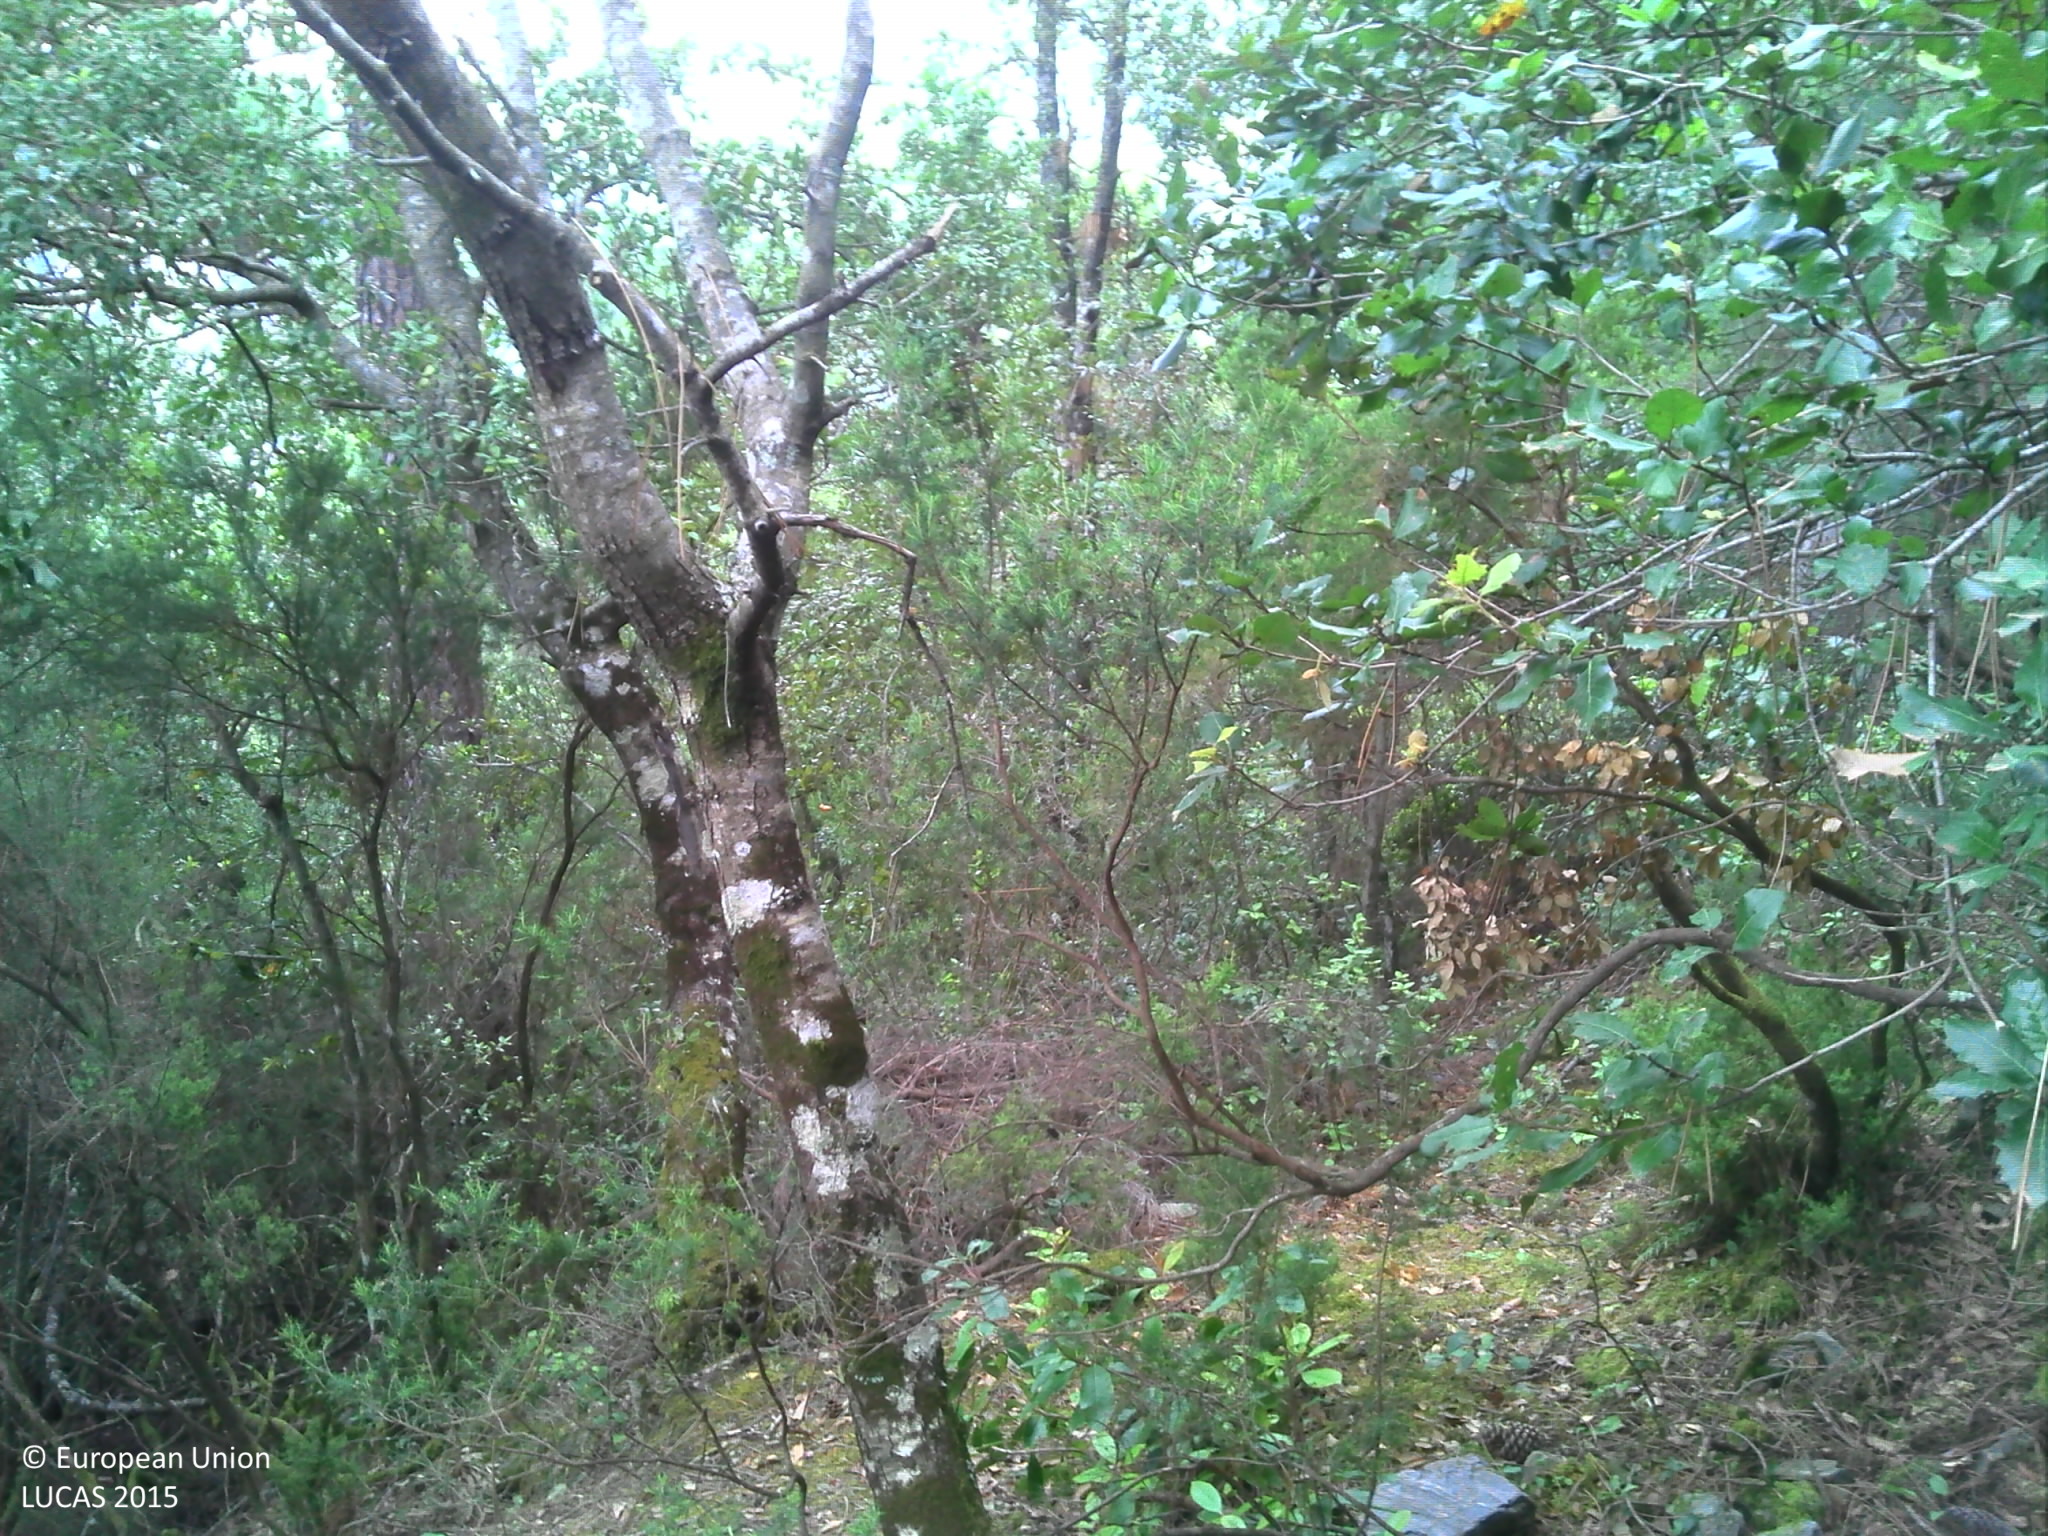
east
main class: Woodland
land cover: Pine dominated coniferous woodland
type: coniferous forest of the mediterranean region
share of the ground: > 75 %
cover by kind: coniferous forest trees 75 %, broadleaved forest trees 15 %, shrubs 10 %
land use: Forestry
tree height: > 5 m
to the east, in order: Pine dominated coniferous woodland; Fences; Dry stone walls; Nuts trees
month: June
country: FR
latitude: 42.3986
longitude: 9.2858
